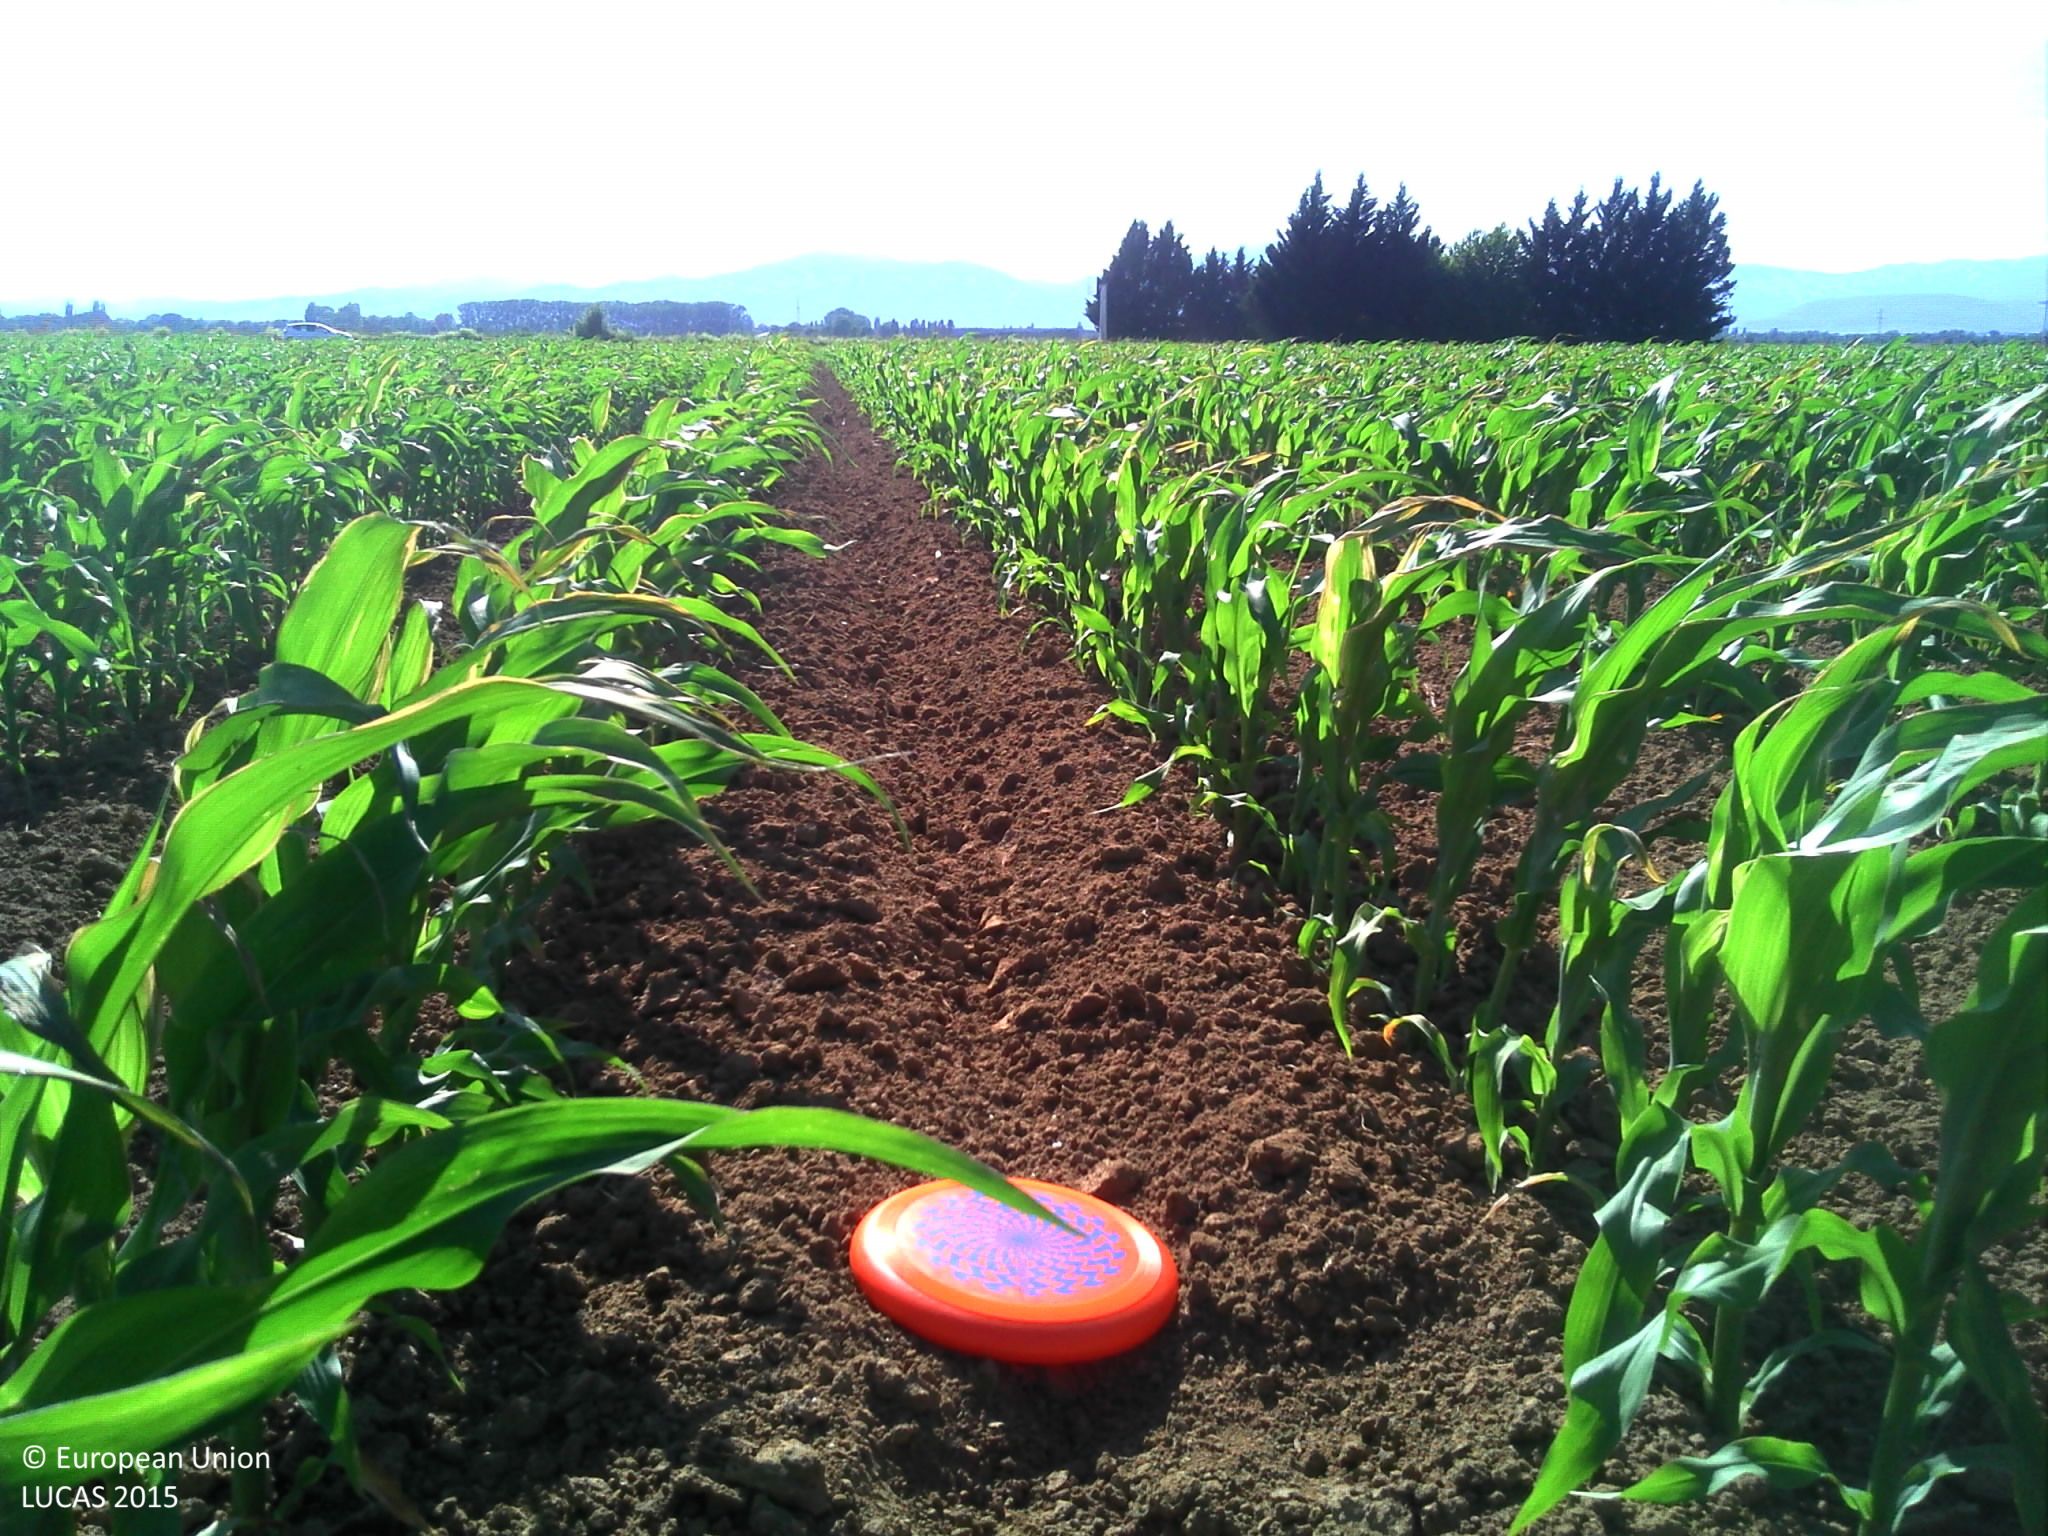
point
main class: Cropland
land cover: Maize
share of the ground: 50 - 75 %
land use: Agriculture (excluding fallow land and kitchen gardens)
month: June
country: FR
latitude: 47.8327
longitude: 7.3963
